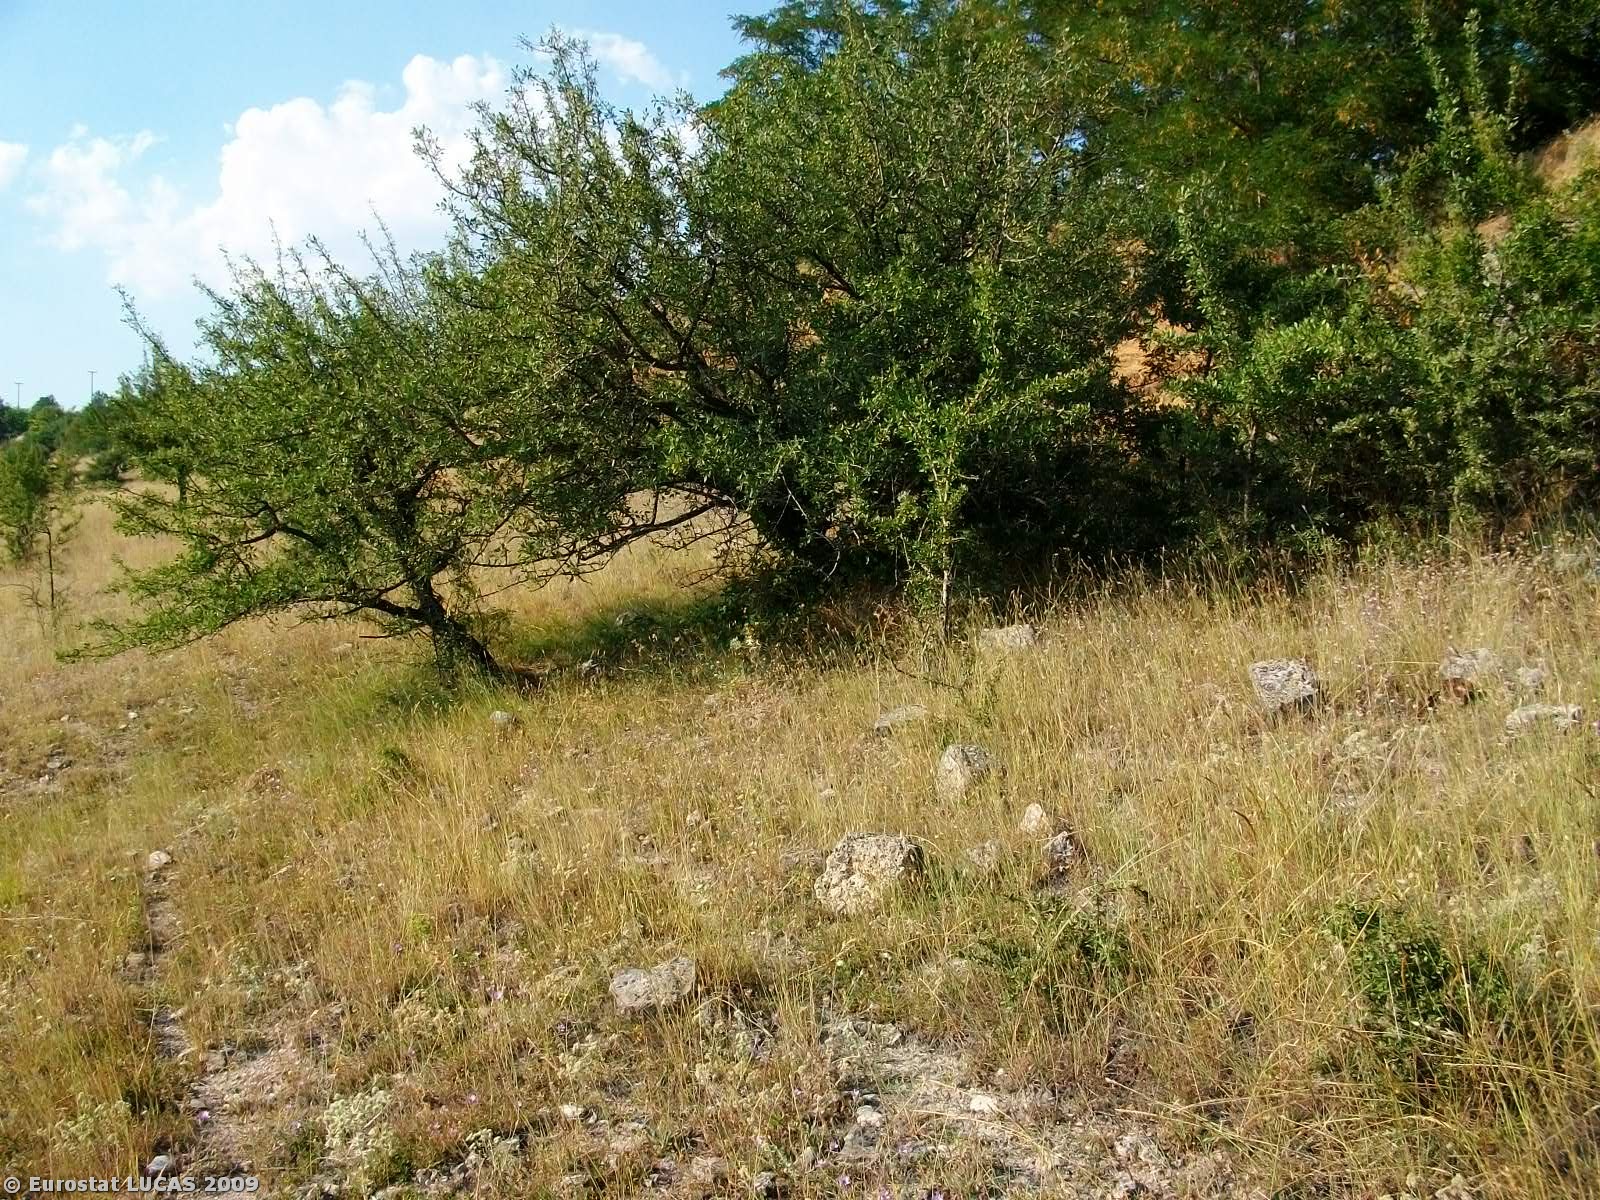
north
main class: Grassland
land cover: Grassland with sparse tree/shrub cover
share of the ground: > 75 %
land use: Unused
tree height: > 5 m
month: July
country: GR
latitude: 40.2431
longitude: 21.8289
